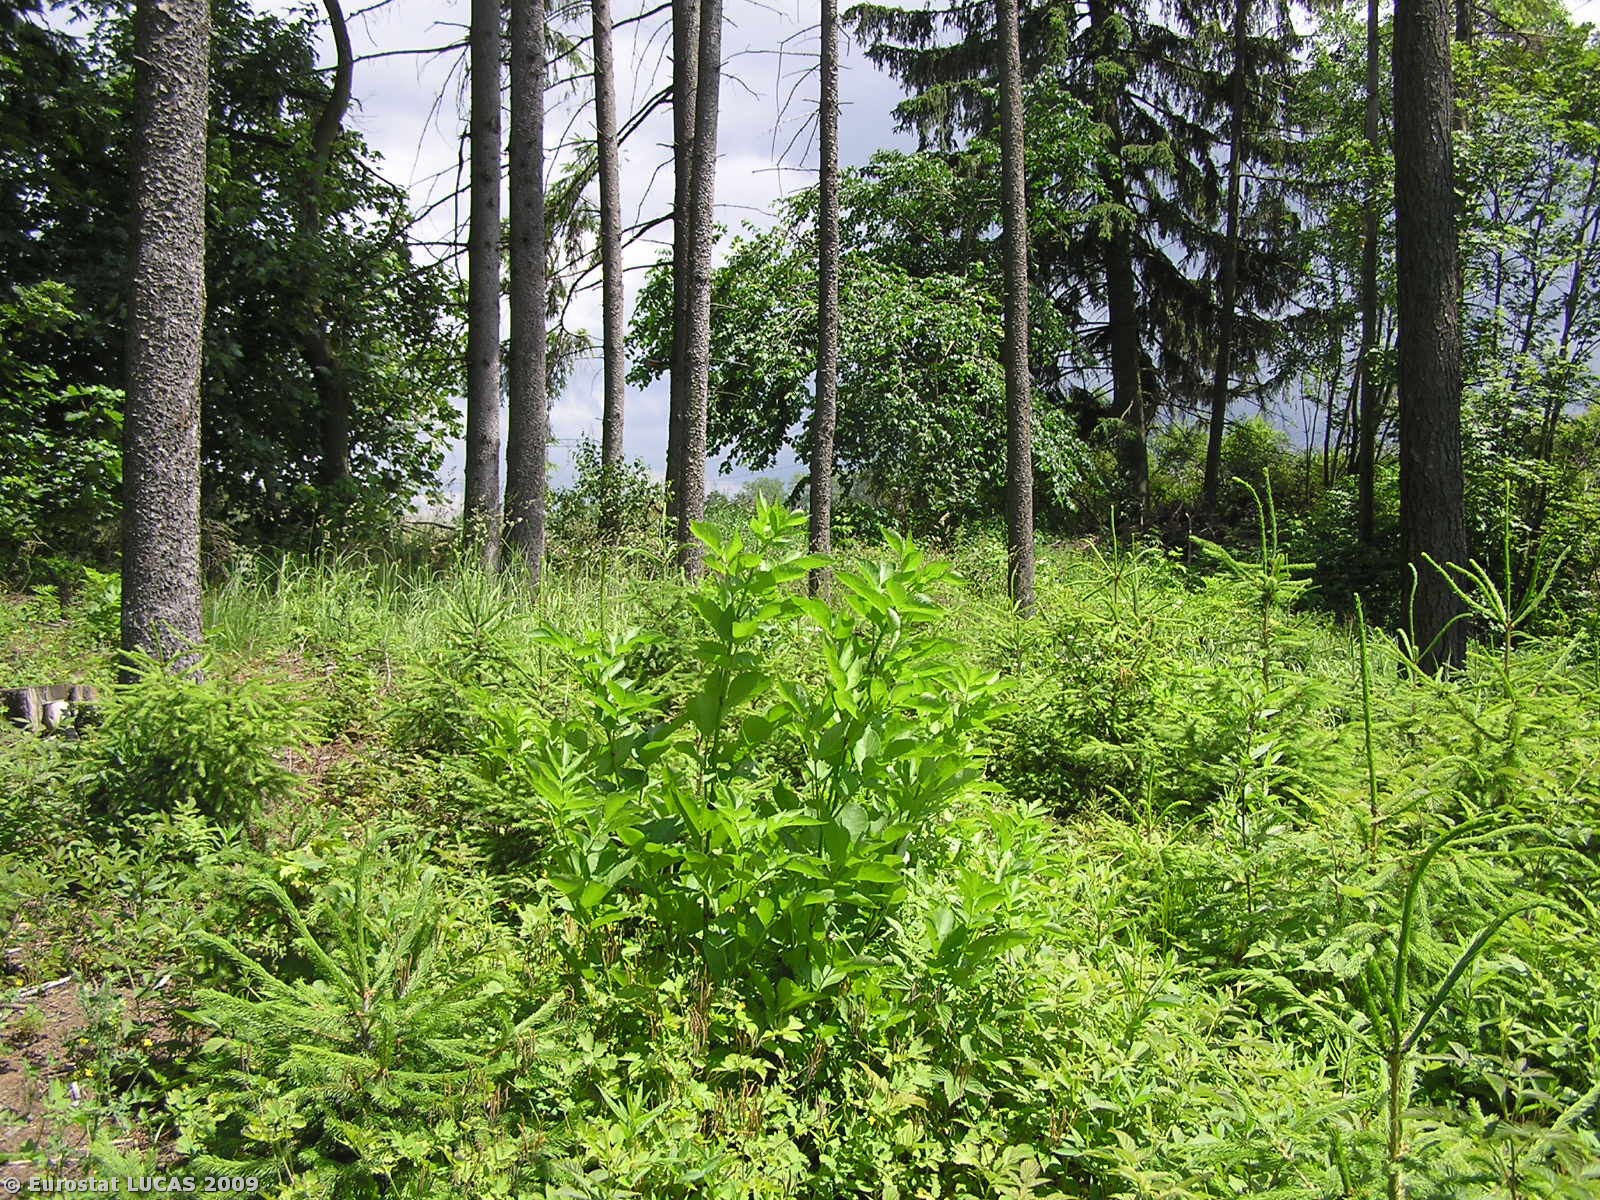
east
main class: Woodland
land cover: Coniferous woodland
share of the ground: 25 - 50 %
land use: Forestry
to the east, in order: Coniferous woodland; Grassland without tree/shrub cover; Tracks; Potatoes
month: June
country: CZ
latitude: 49.4806
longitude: 14.9851
